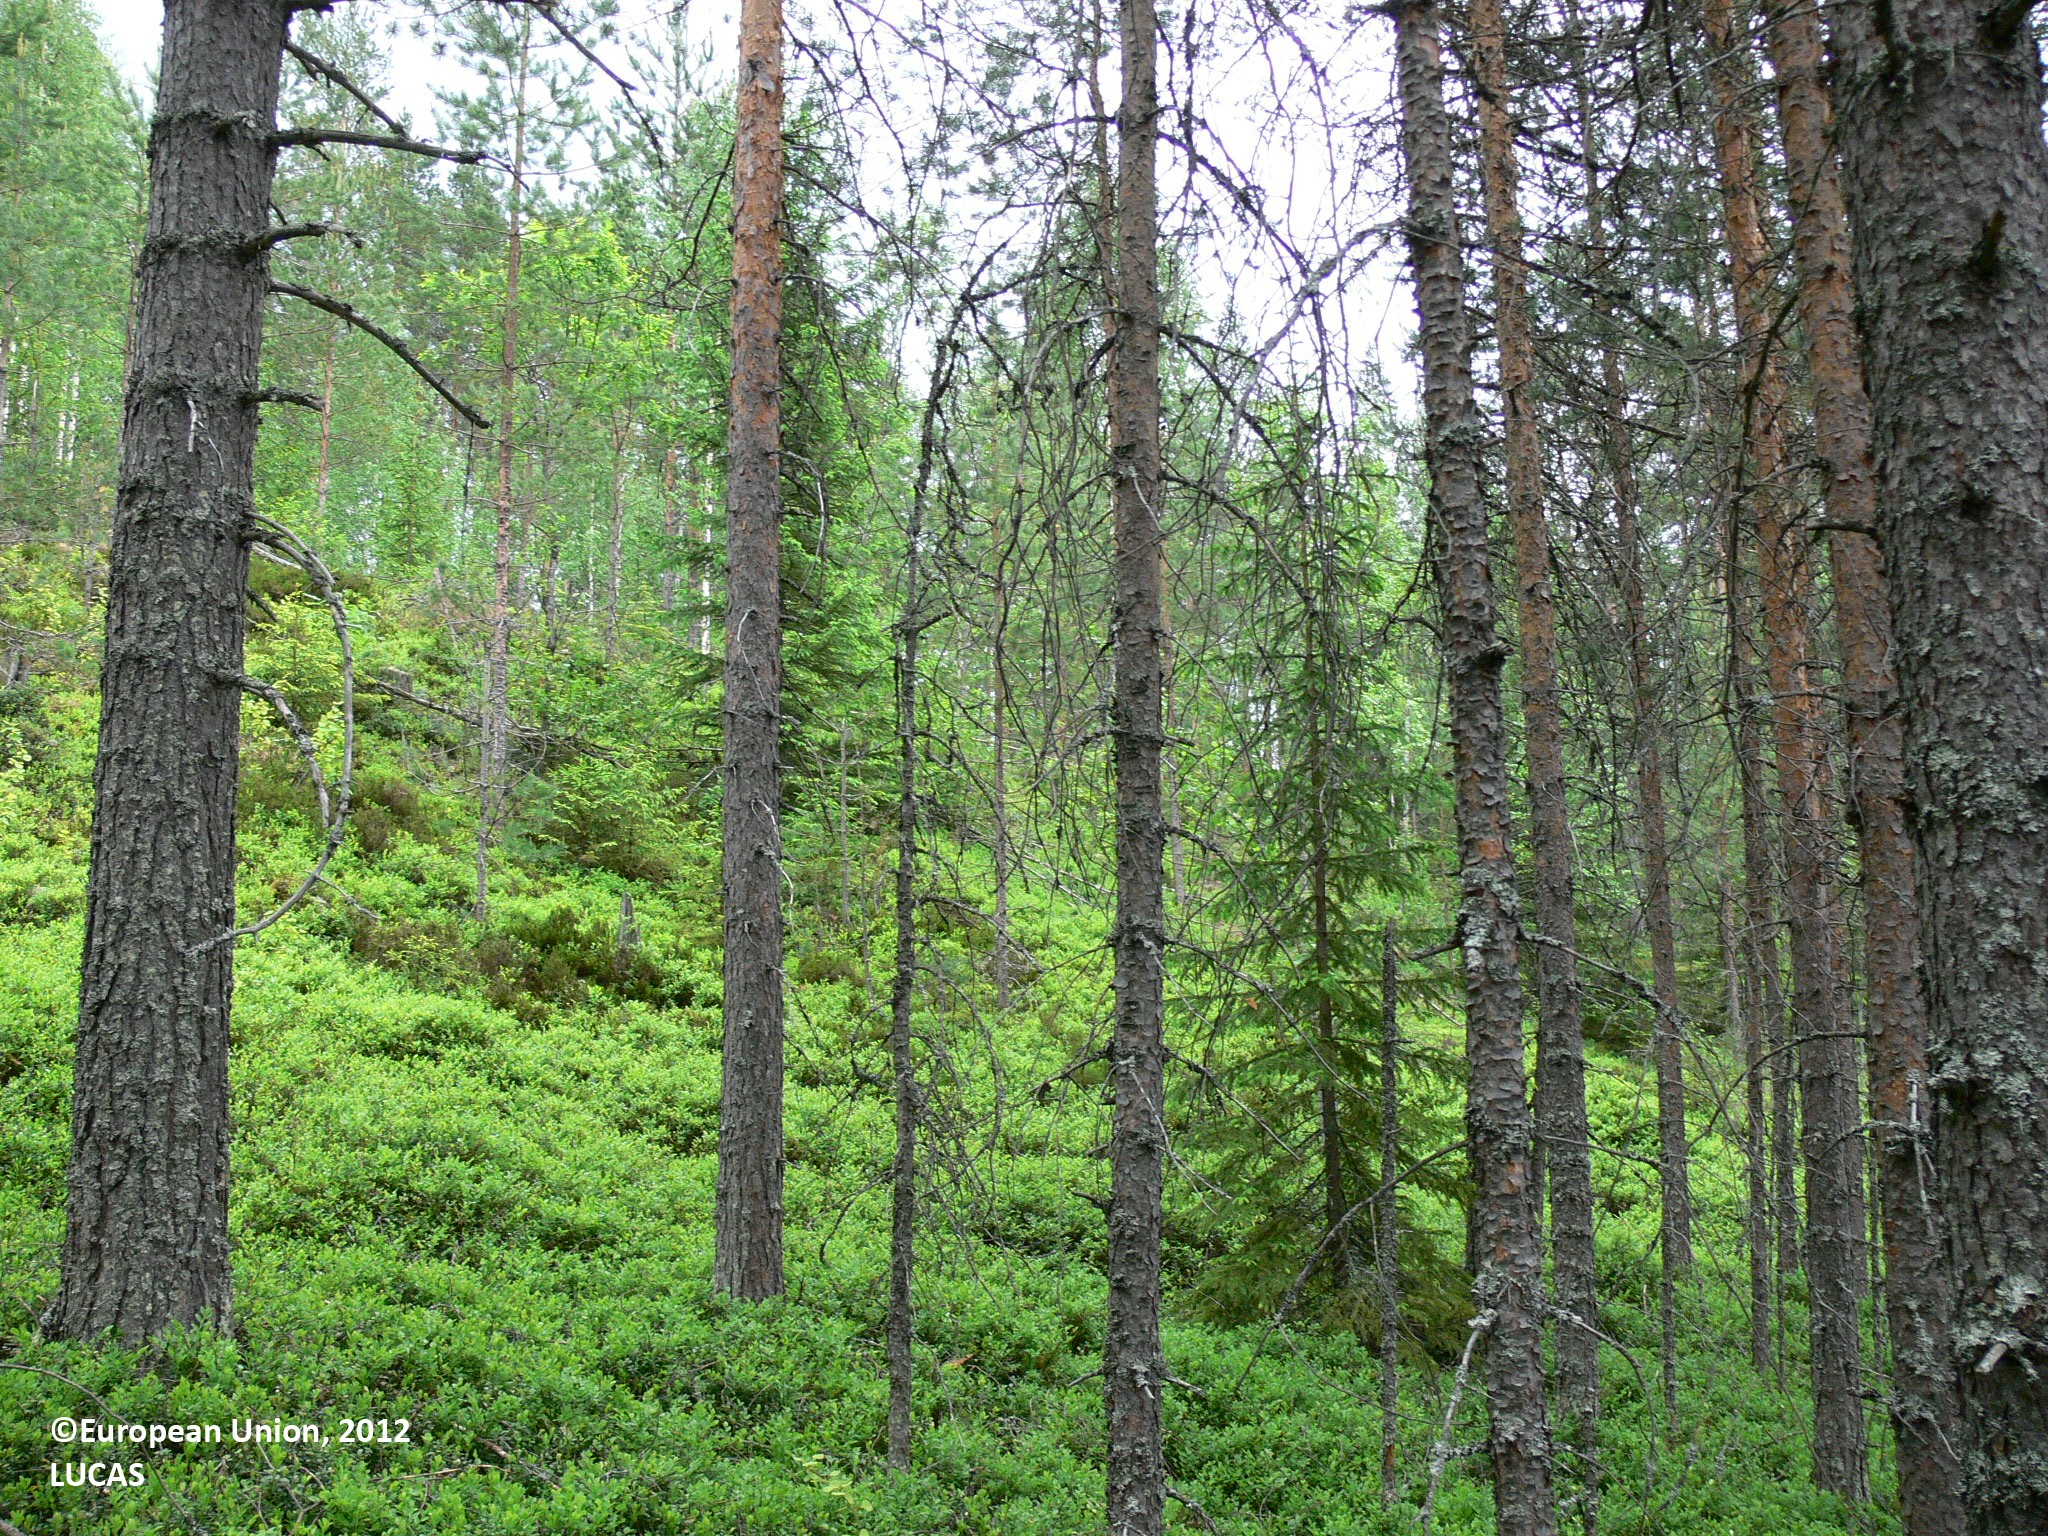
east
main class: Woodland
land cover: Pine dominated coniferous woodland
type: boreal forest
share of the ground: > 75 %
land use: Forestry
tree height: > 5 m
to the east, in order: Pine dominated coniferous woodland; Pine dominated mixed woodland; Pine dominated coniferous woodland; Other coniferous woodland; Other mixed woodland; Ditches and canals; Pine dominated mixed woodland; Pine dominated coniferous woodland; Ditches and canals; Pine dominated mixed woodland; Other mixed woodland
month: June
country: FI
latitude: 62.9290
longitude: 29.8872
